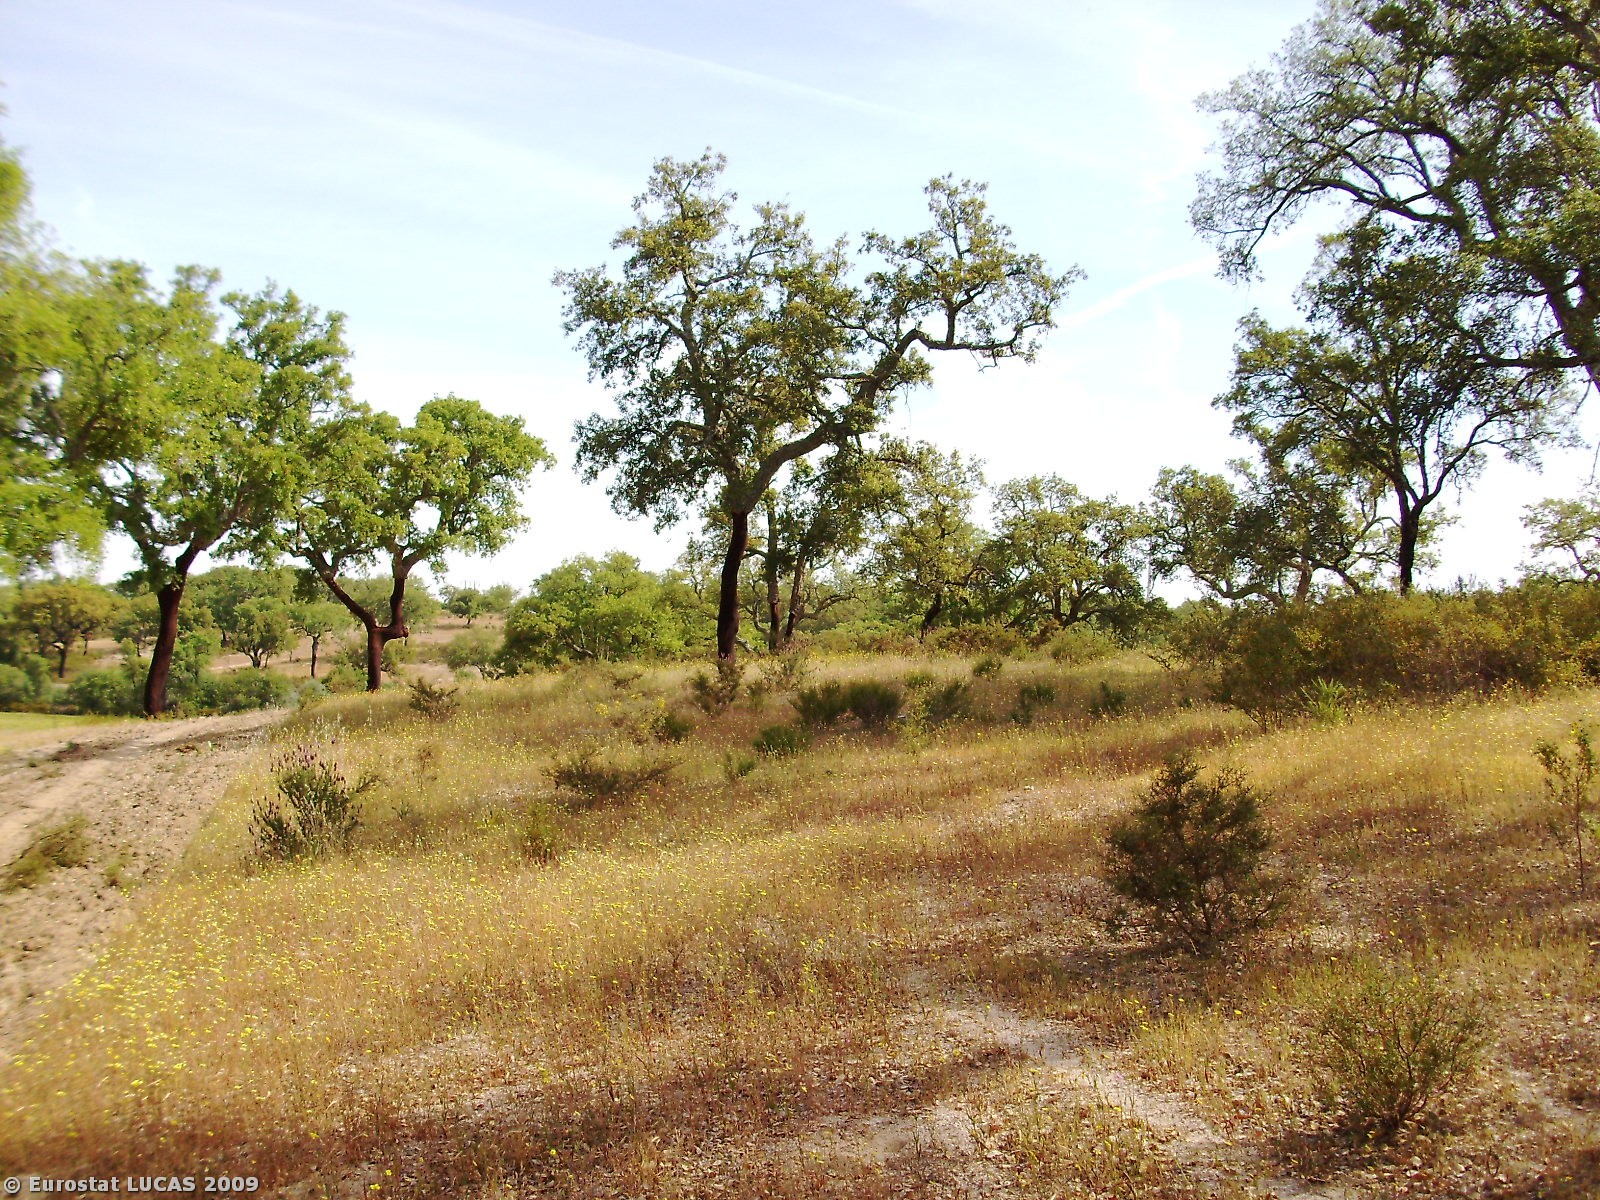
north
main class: Woodland
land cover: Broadleaved woodland
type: broadleaved evergreen forest
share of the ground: 50 - 75 %
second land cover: Spontaneously vegetated surfaces
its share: 25 - 50 %
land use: Forestry
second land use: Fallow land
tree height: > 5 m
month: May
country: PT
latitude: 39.0633
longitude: -8.0228
